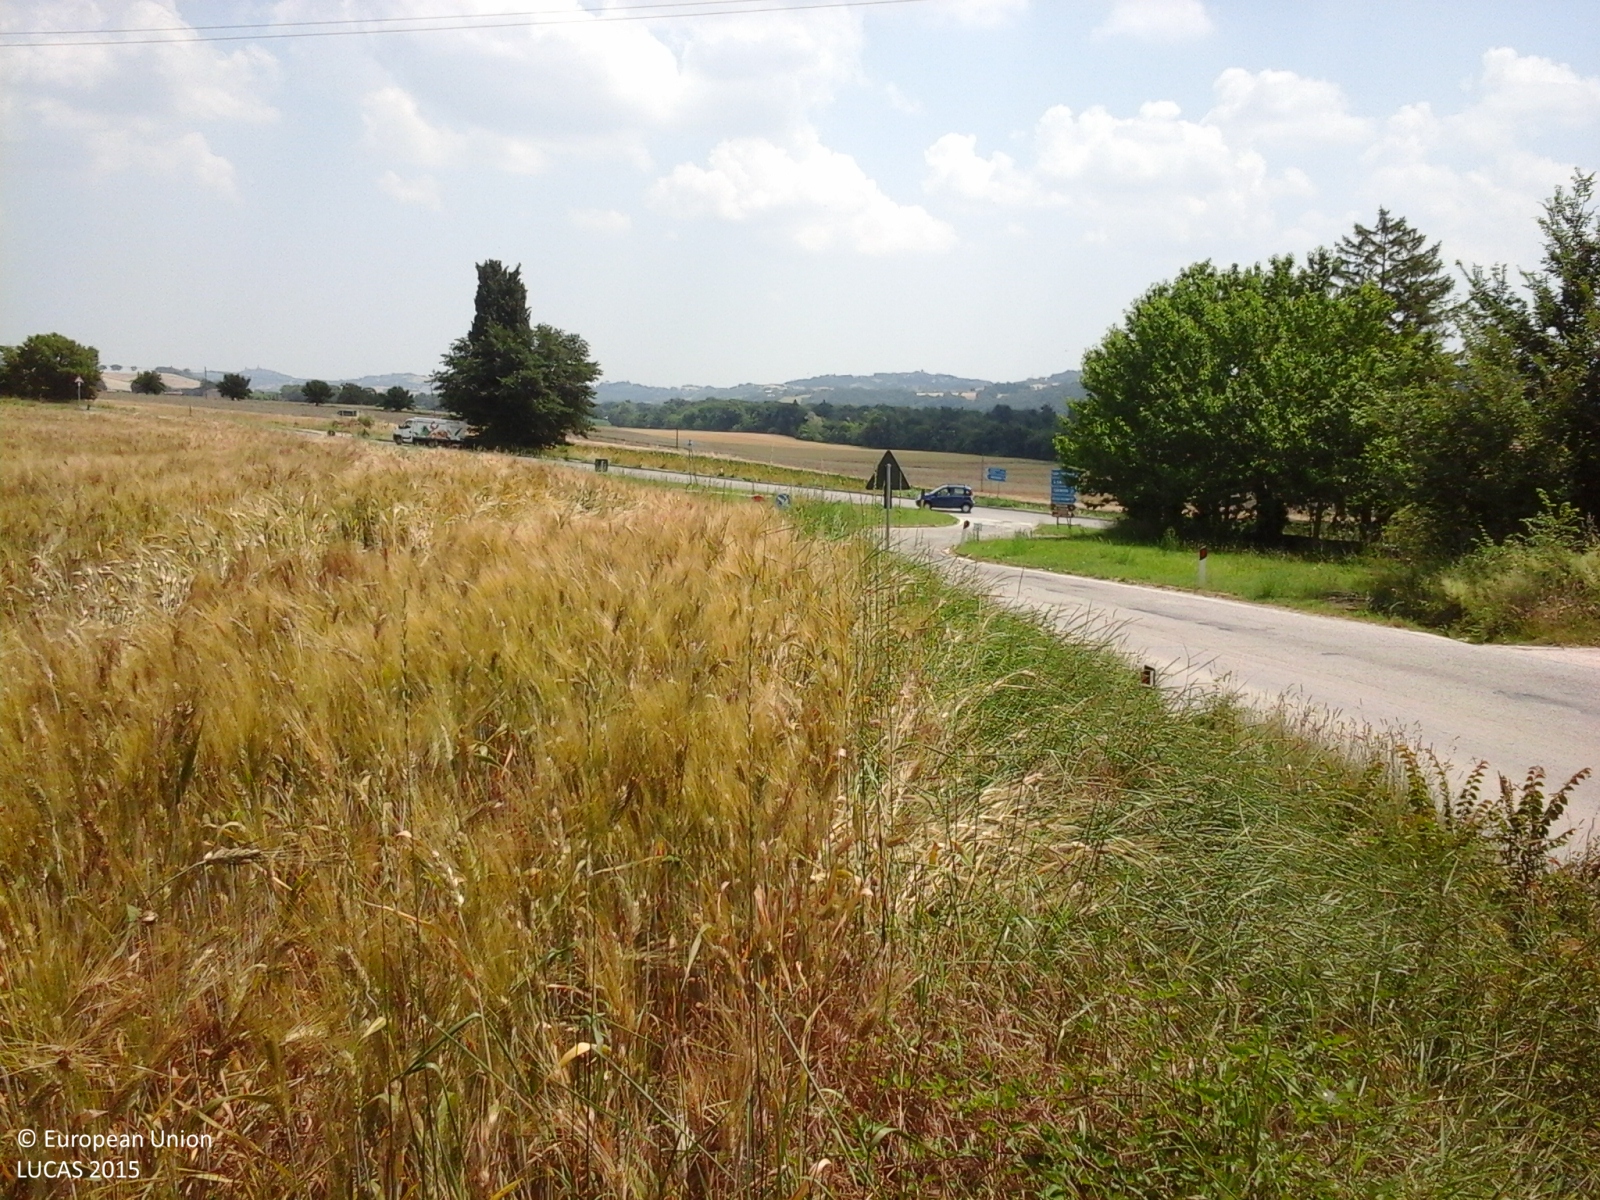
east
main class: Cropland
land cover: Durum wheat
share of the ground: > 75 %
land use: Agriculture (excluding fallow land and kitchen gardens)
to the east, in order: Durum wheat; Electric lines; Durum wheat; Ditches and canals; Grass margins; Tracks; Grass margins; Ditches and canals; Potatoes; Grass margins; Paved roads, cycling and walking lanes; Grass margins; Lines of trees; Durum wheat
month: June
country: IT
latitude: 43.2294
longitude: 13.4017
